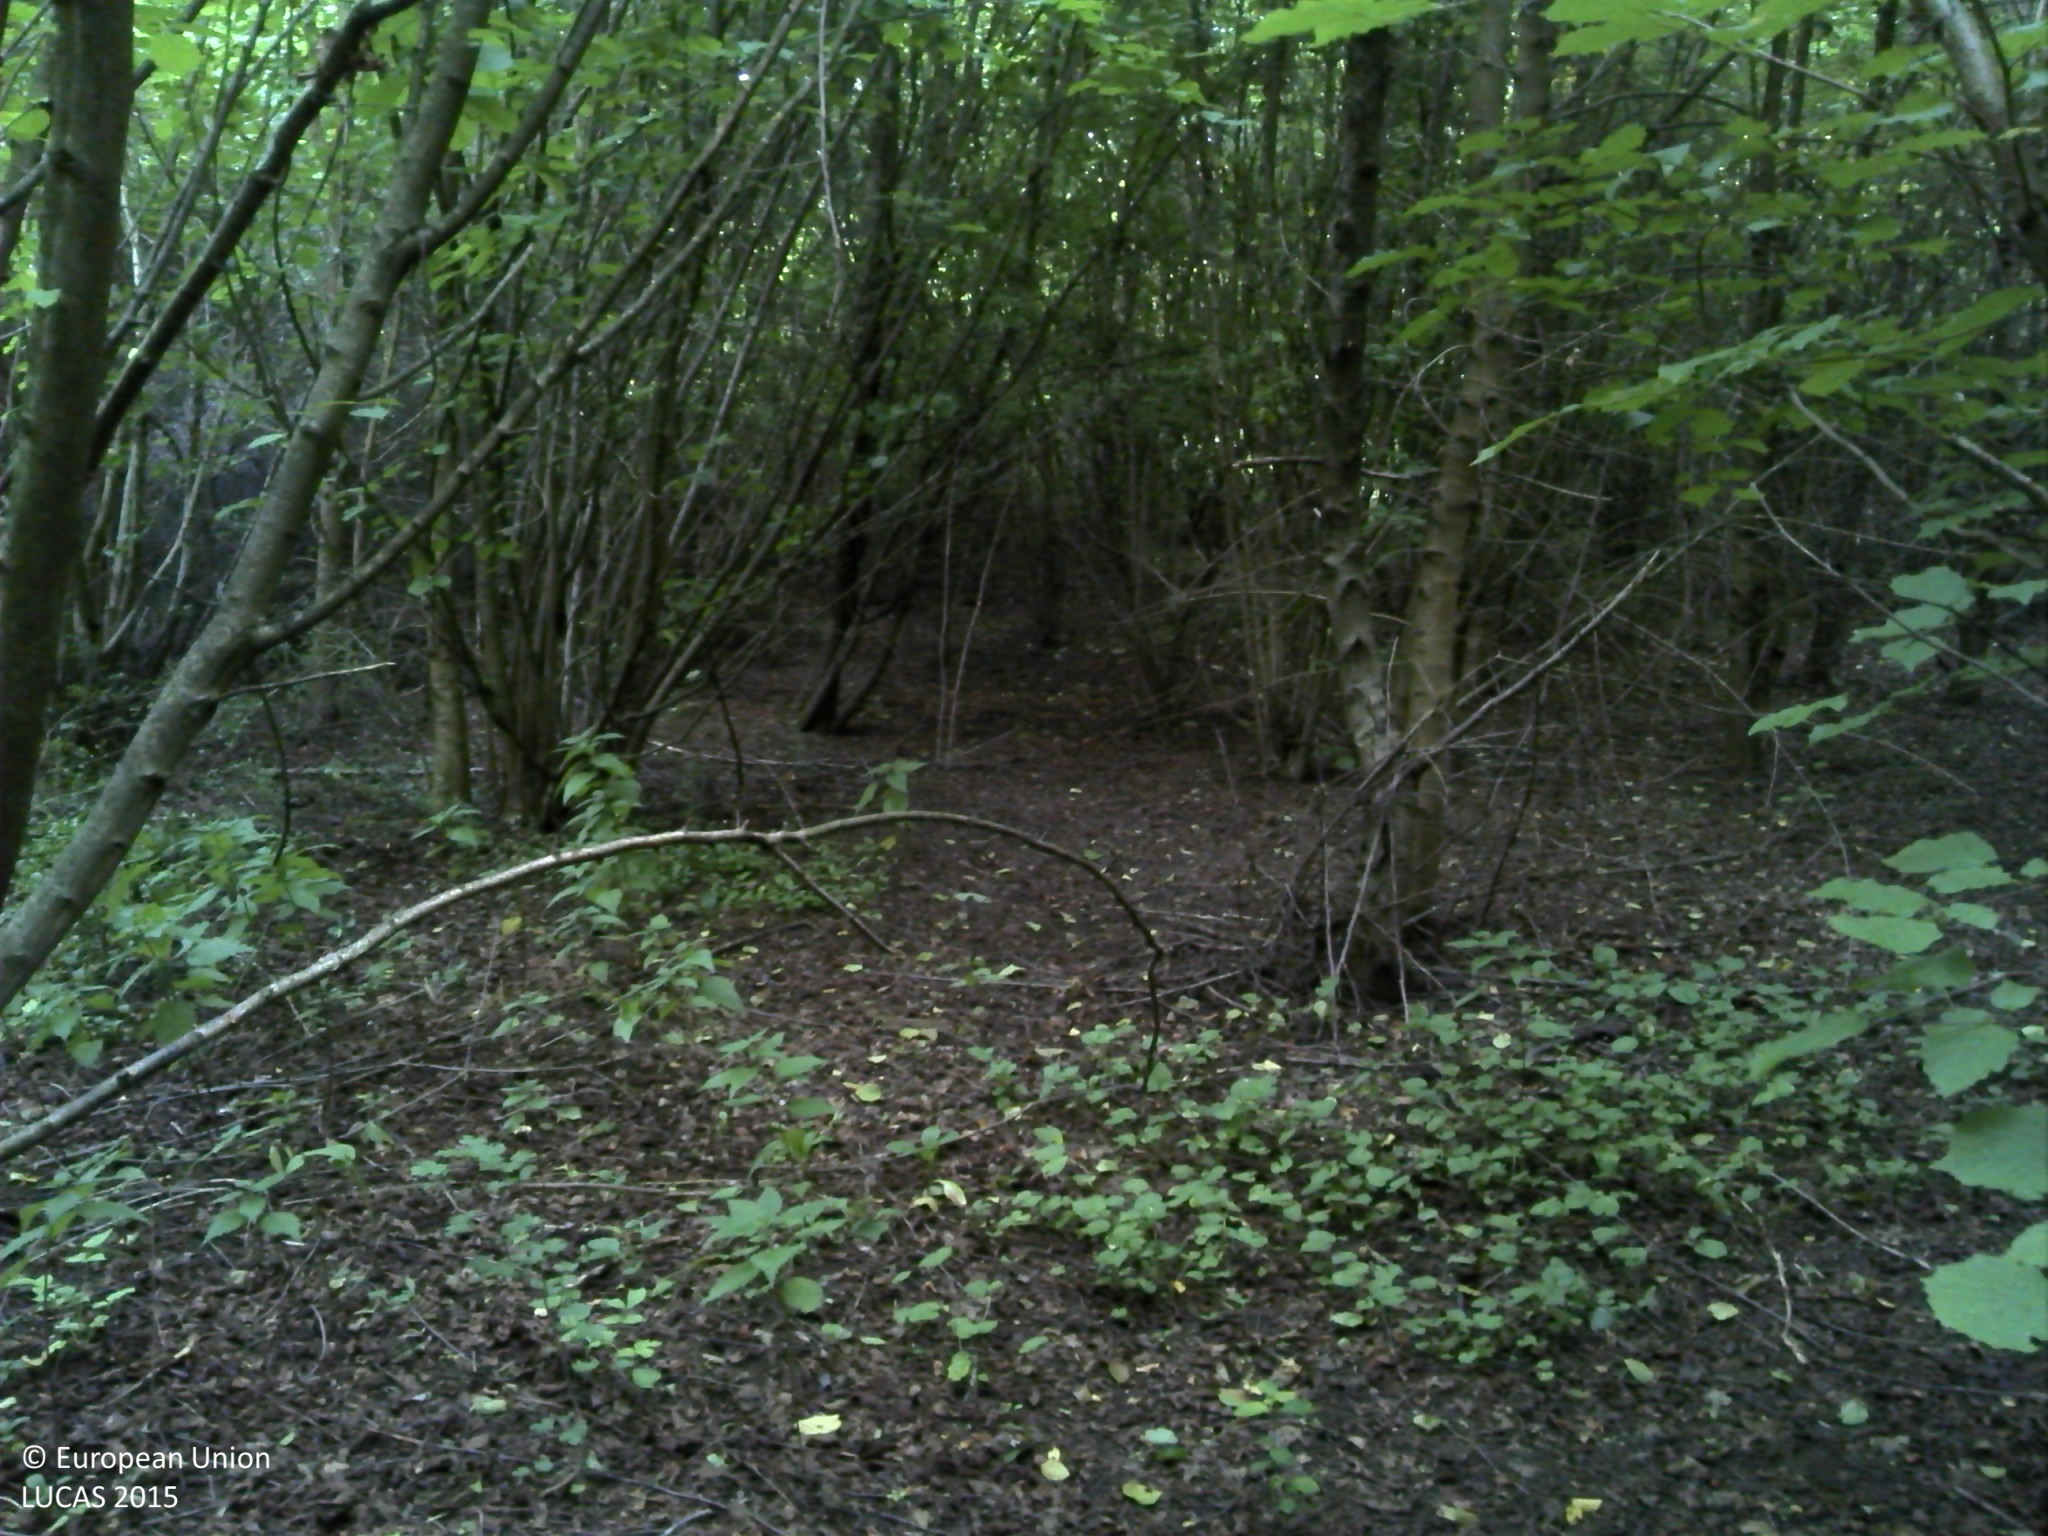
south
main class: Woodland
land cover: Broadleaved woodland
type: acidophilous oak and oak-birch forest
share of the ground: > 75 %
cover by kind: broadleaved forest trees 100 %
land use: Forestry
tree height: > 5 m
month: June
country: HR
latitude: 45.3122
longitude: 17.2065
